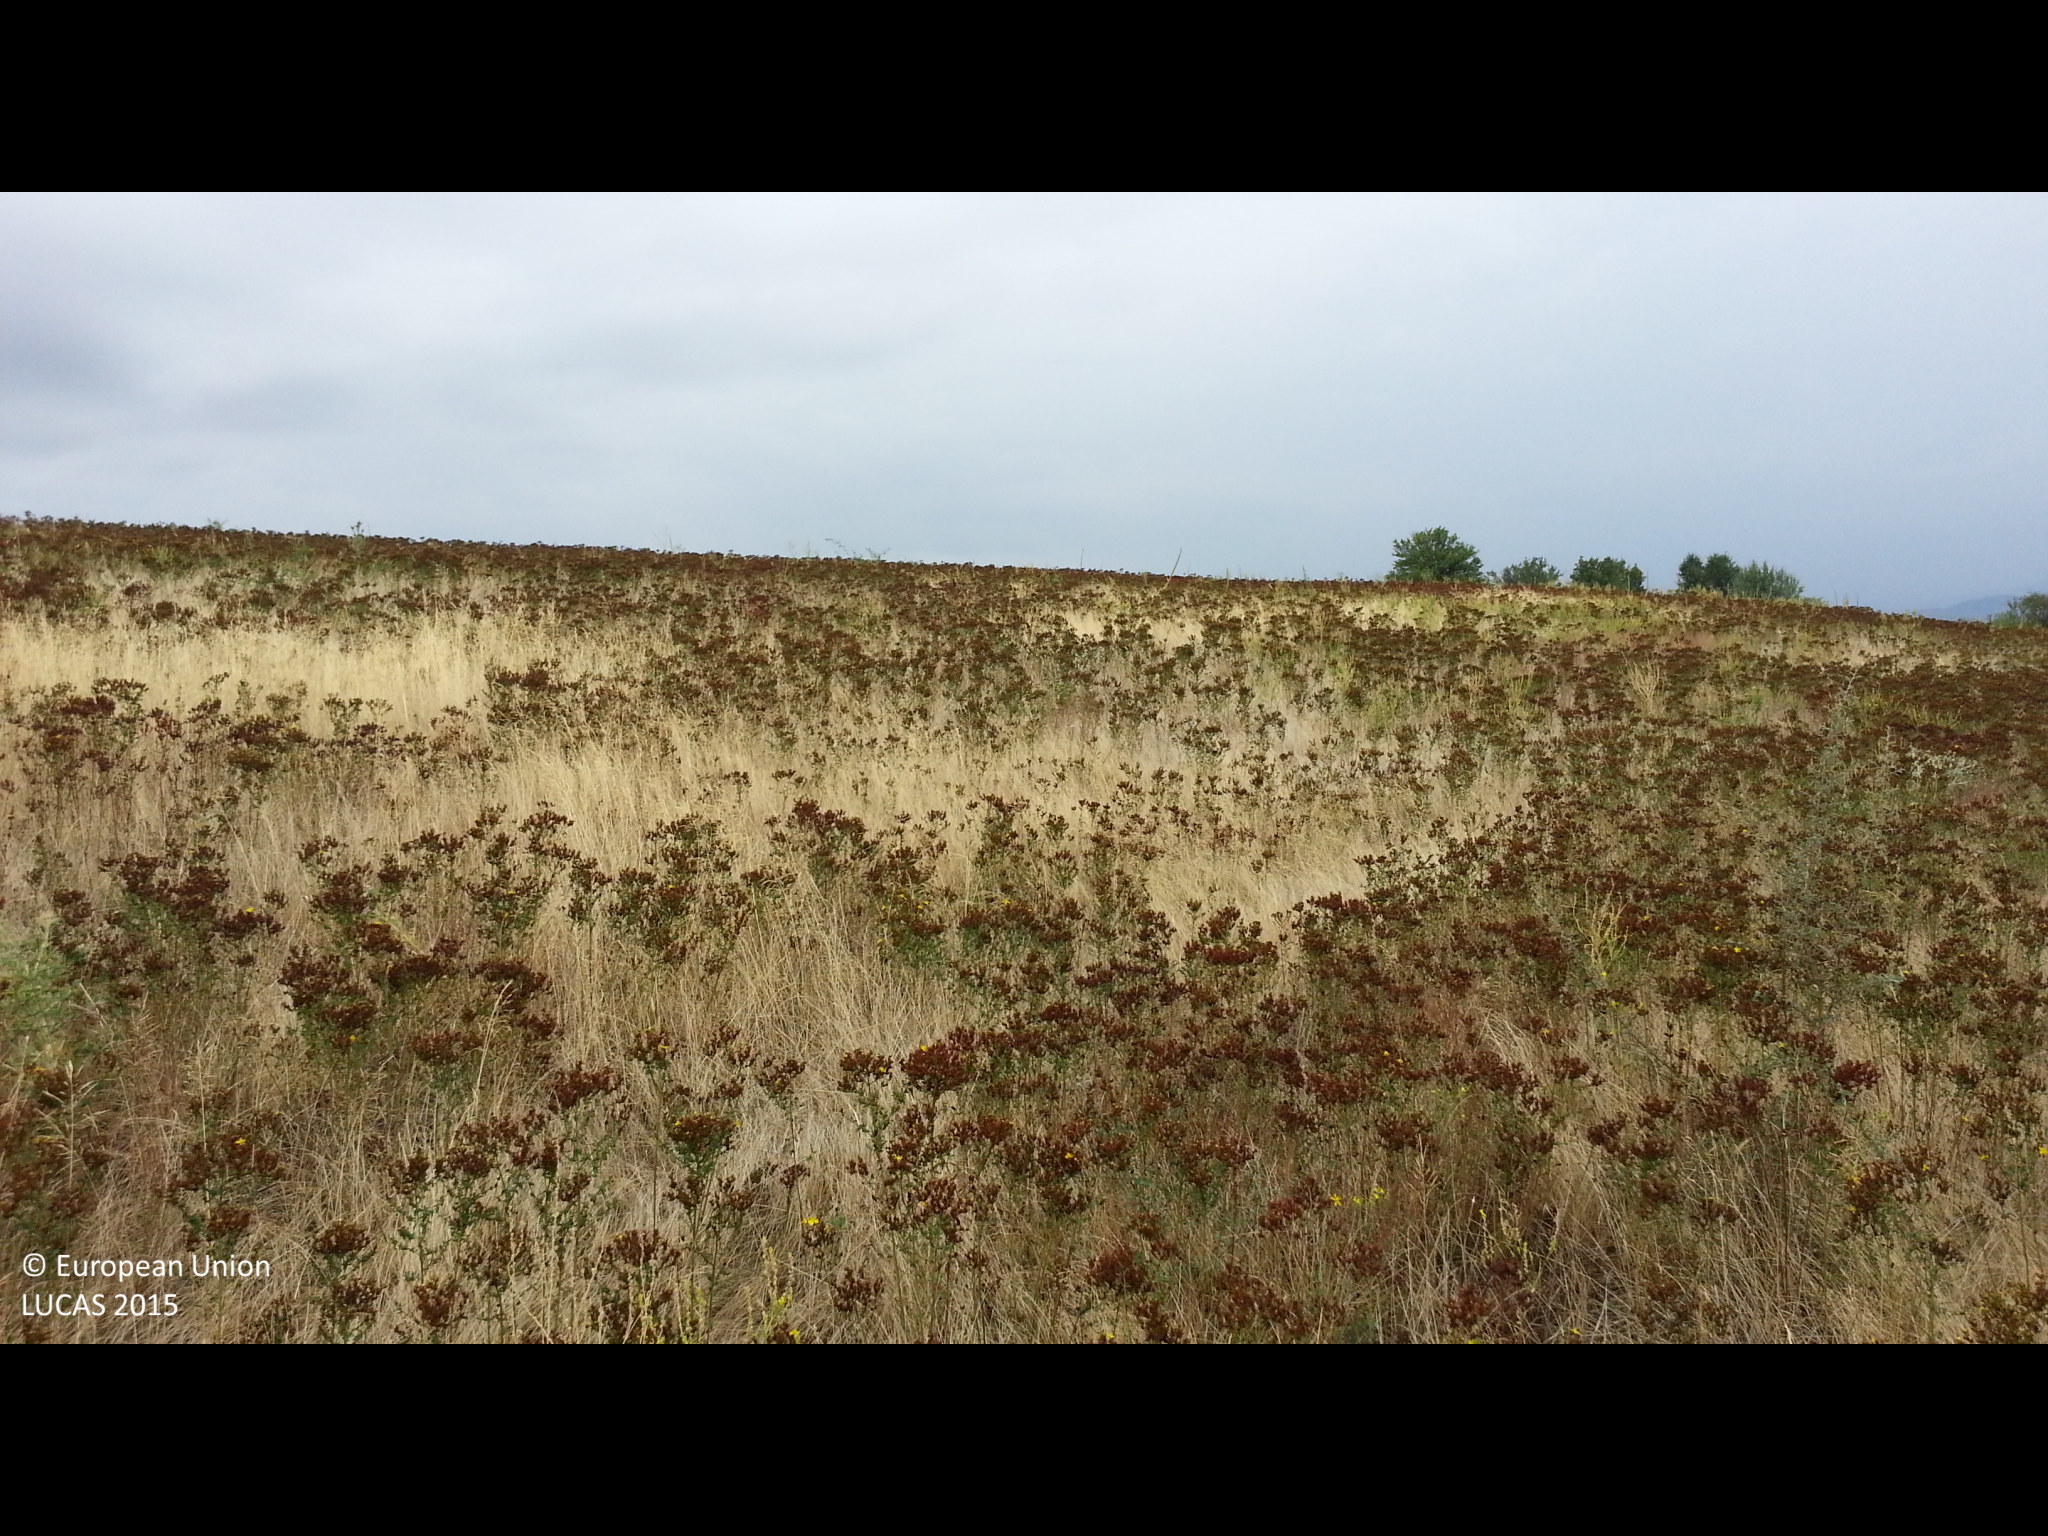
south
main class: Grassland
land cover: Spontaneously vegetated surfaces
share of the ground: > 75 %
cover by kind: herbaceous plants 100 %
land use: Fallow land
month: August
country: BG
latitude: 42.3009
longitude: 22.8945
